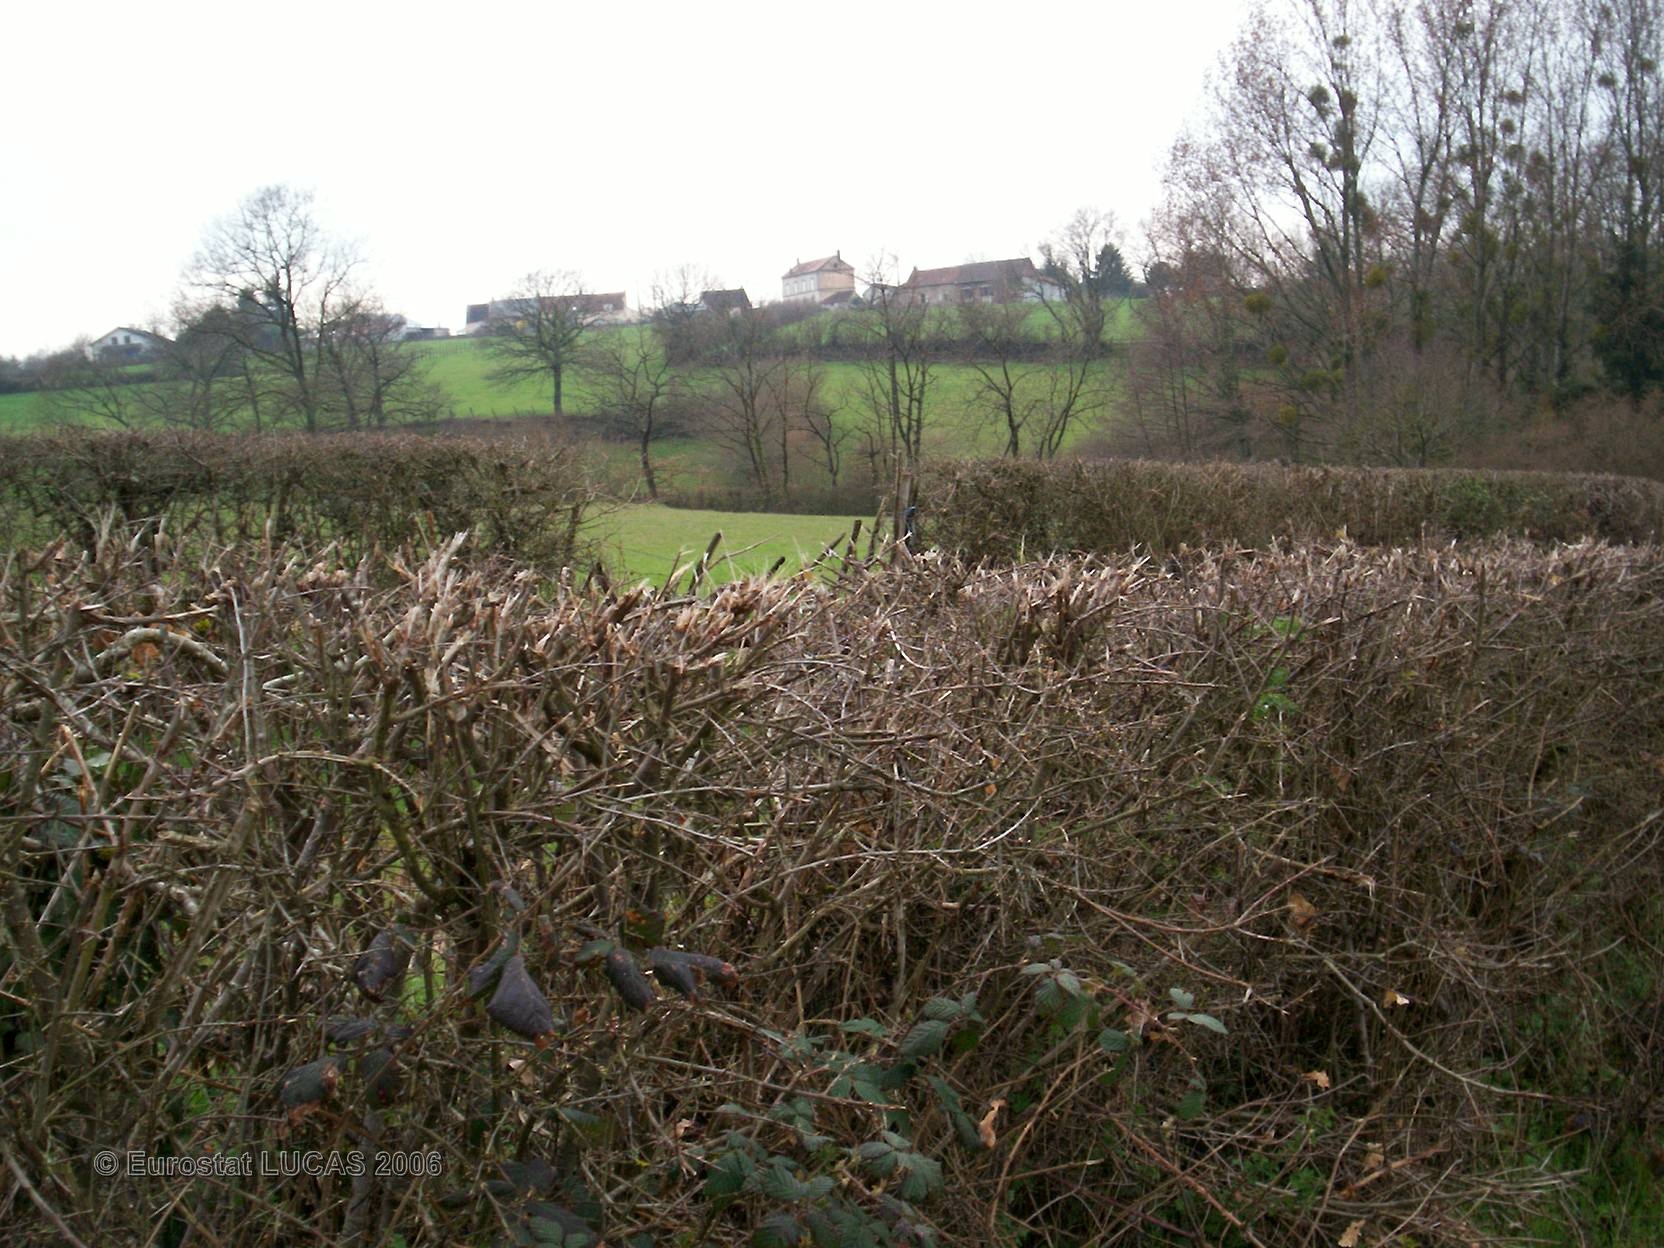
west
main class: Grassland
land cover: Grassland without tree/shrub cover
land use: Agriculture (excluding fallow land and kitchen gardens)
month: April
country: FR
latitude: 47.3980
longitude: 4.1022
